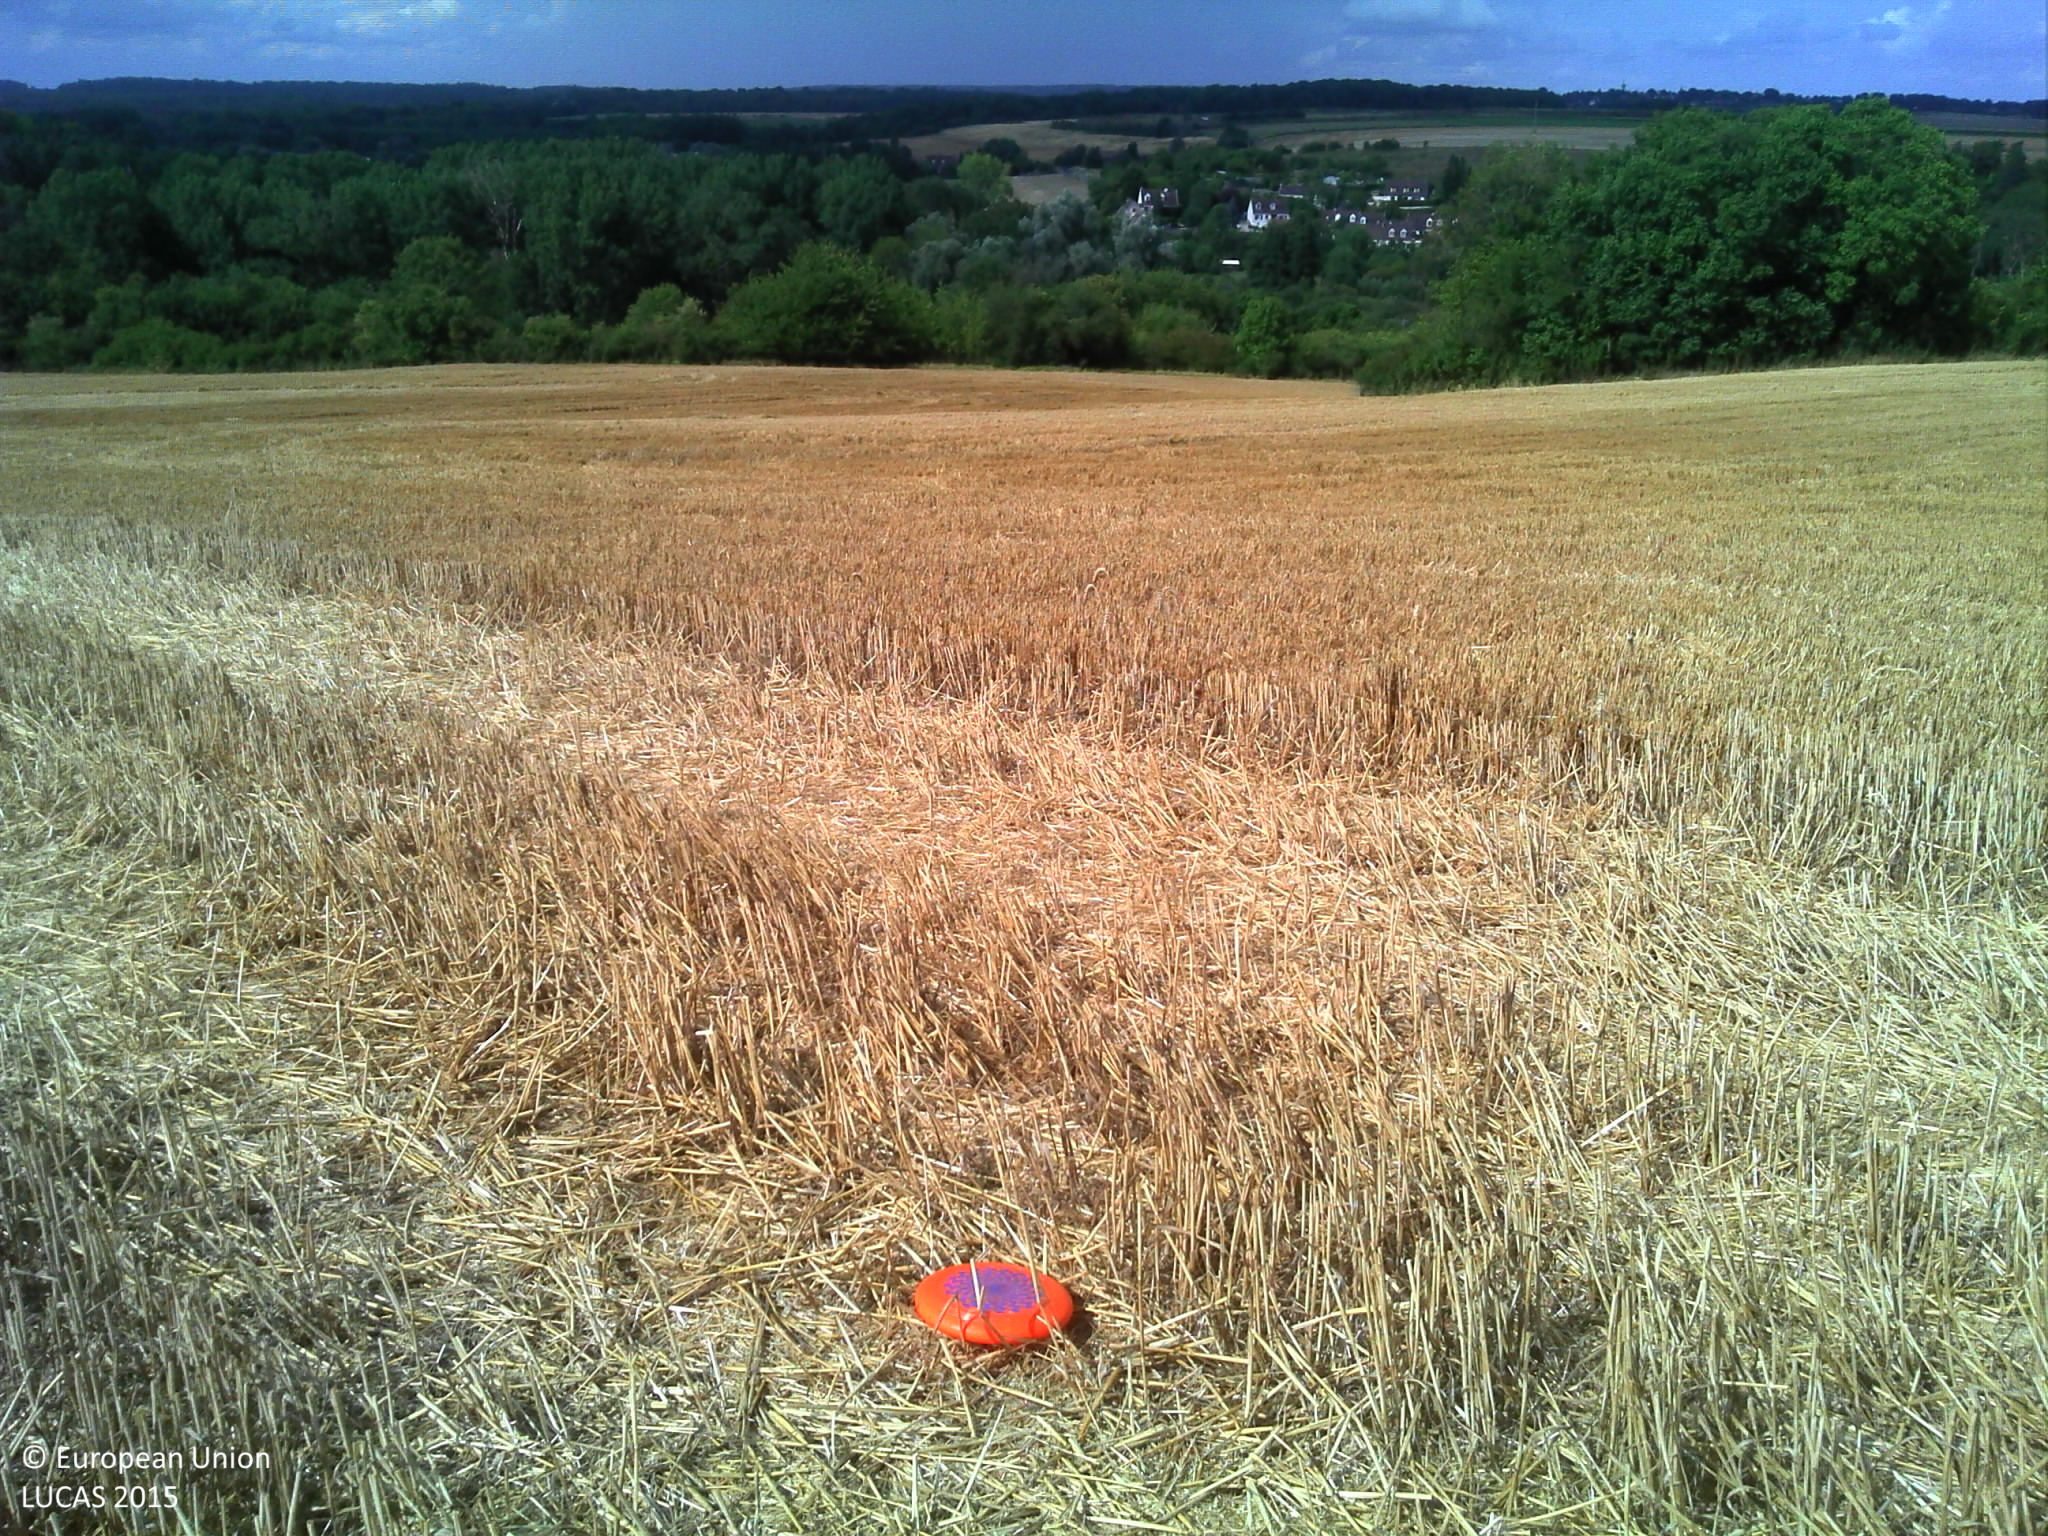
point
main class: Cropland
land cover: Common wheat
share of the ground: > 75 %
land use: Agriculture (excluding fallow land and kitchen gardens)
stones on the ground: < 10 %
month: August
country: FR
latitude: 49.0877
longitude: 1.9749
